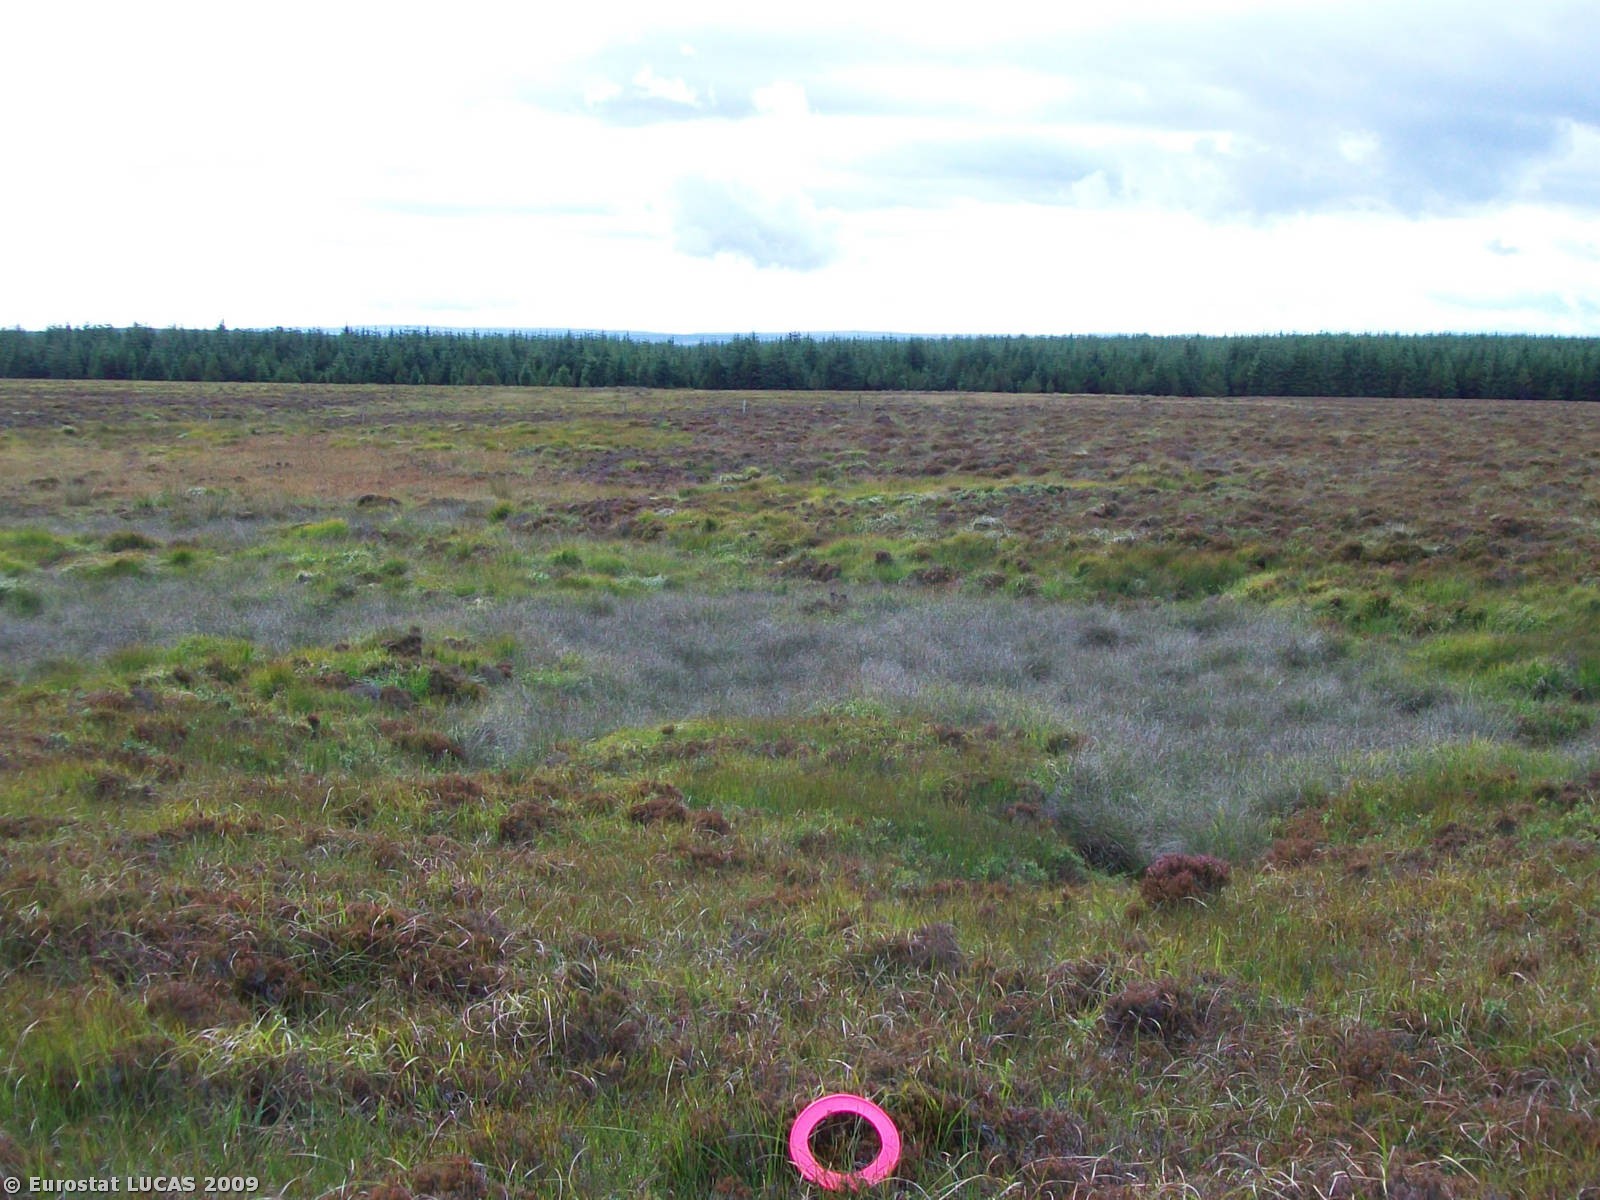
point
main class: Shrubland
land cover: Shrubland without tree cover
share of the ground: > 75 %
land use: Agriculture (excluding fallow land and kitchen gardens)
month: August
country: GB
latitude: 58.5893
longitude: -3.1841
